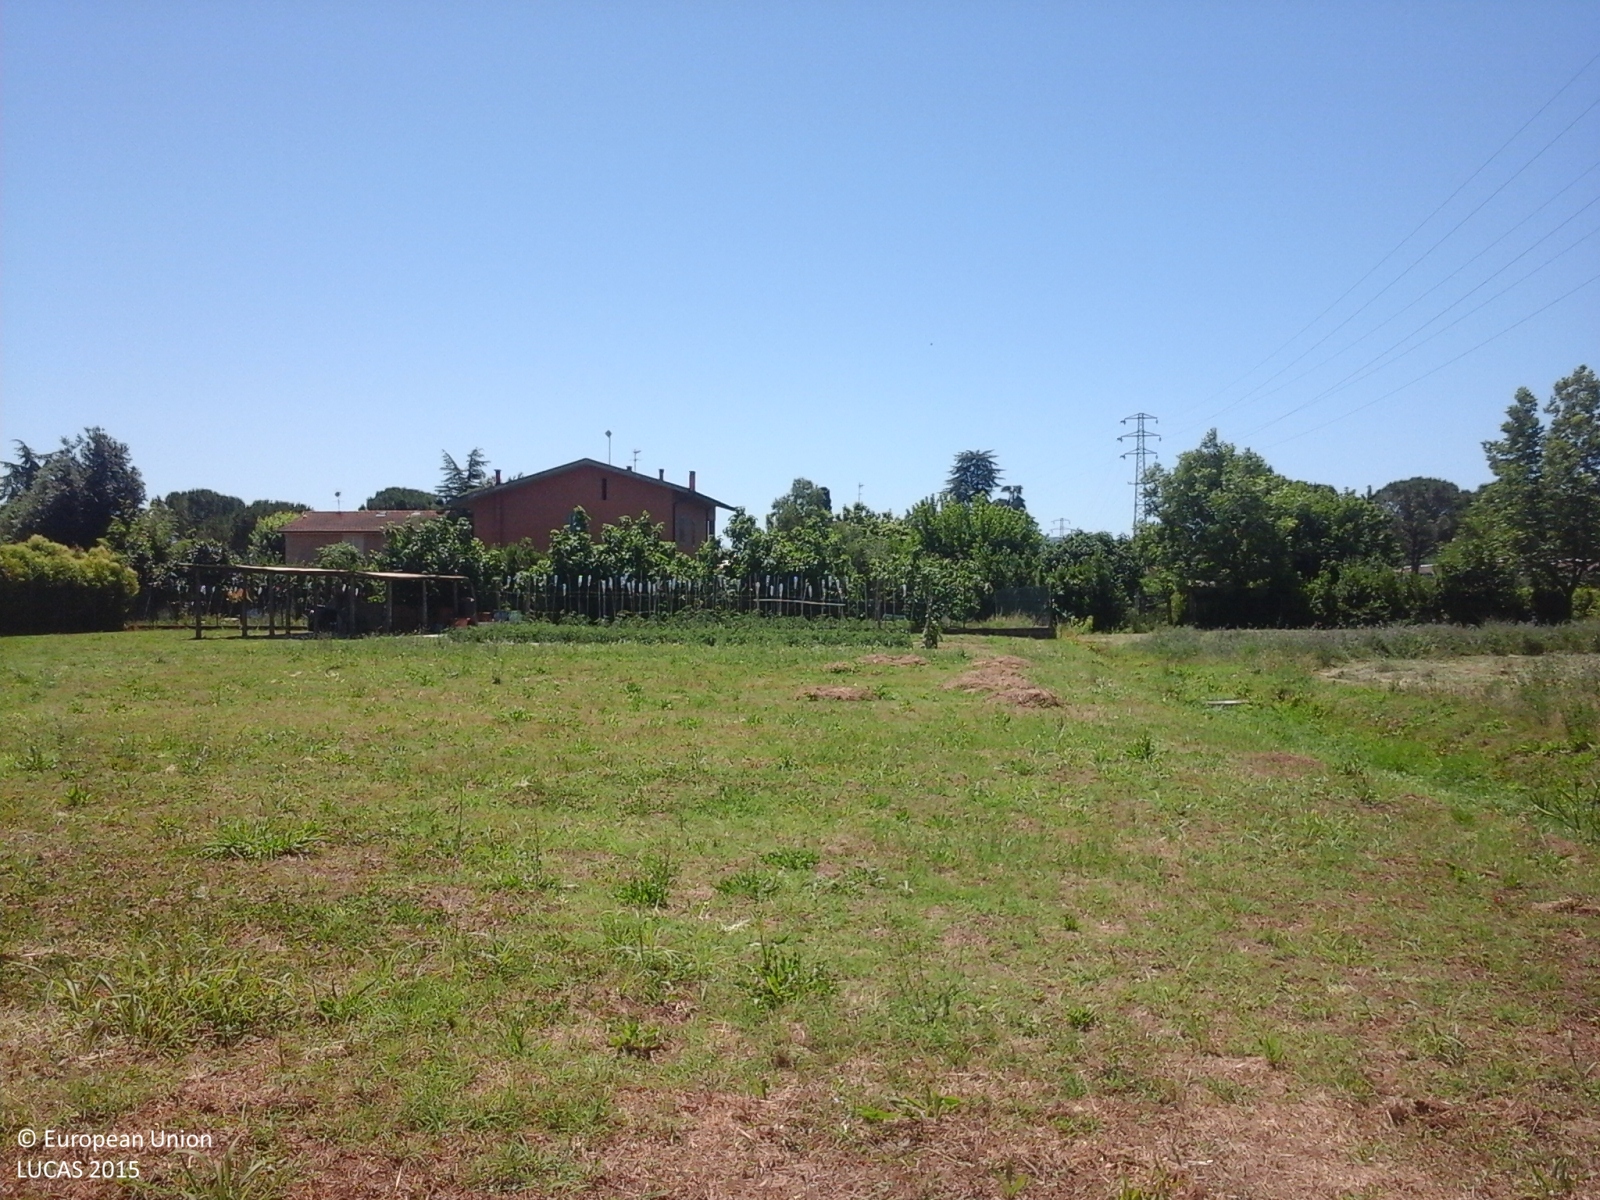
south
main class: Grassland
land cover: Grassland without tree/shrub cover
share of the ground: > 75 %
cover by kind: herbaceous plants 100 %
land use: Agriculture (excluding fallow land and kitchen gardens)
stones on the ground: < 10 %
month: June
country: IT
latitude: 43.5909
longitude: 10.6299
